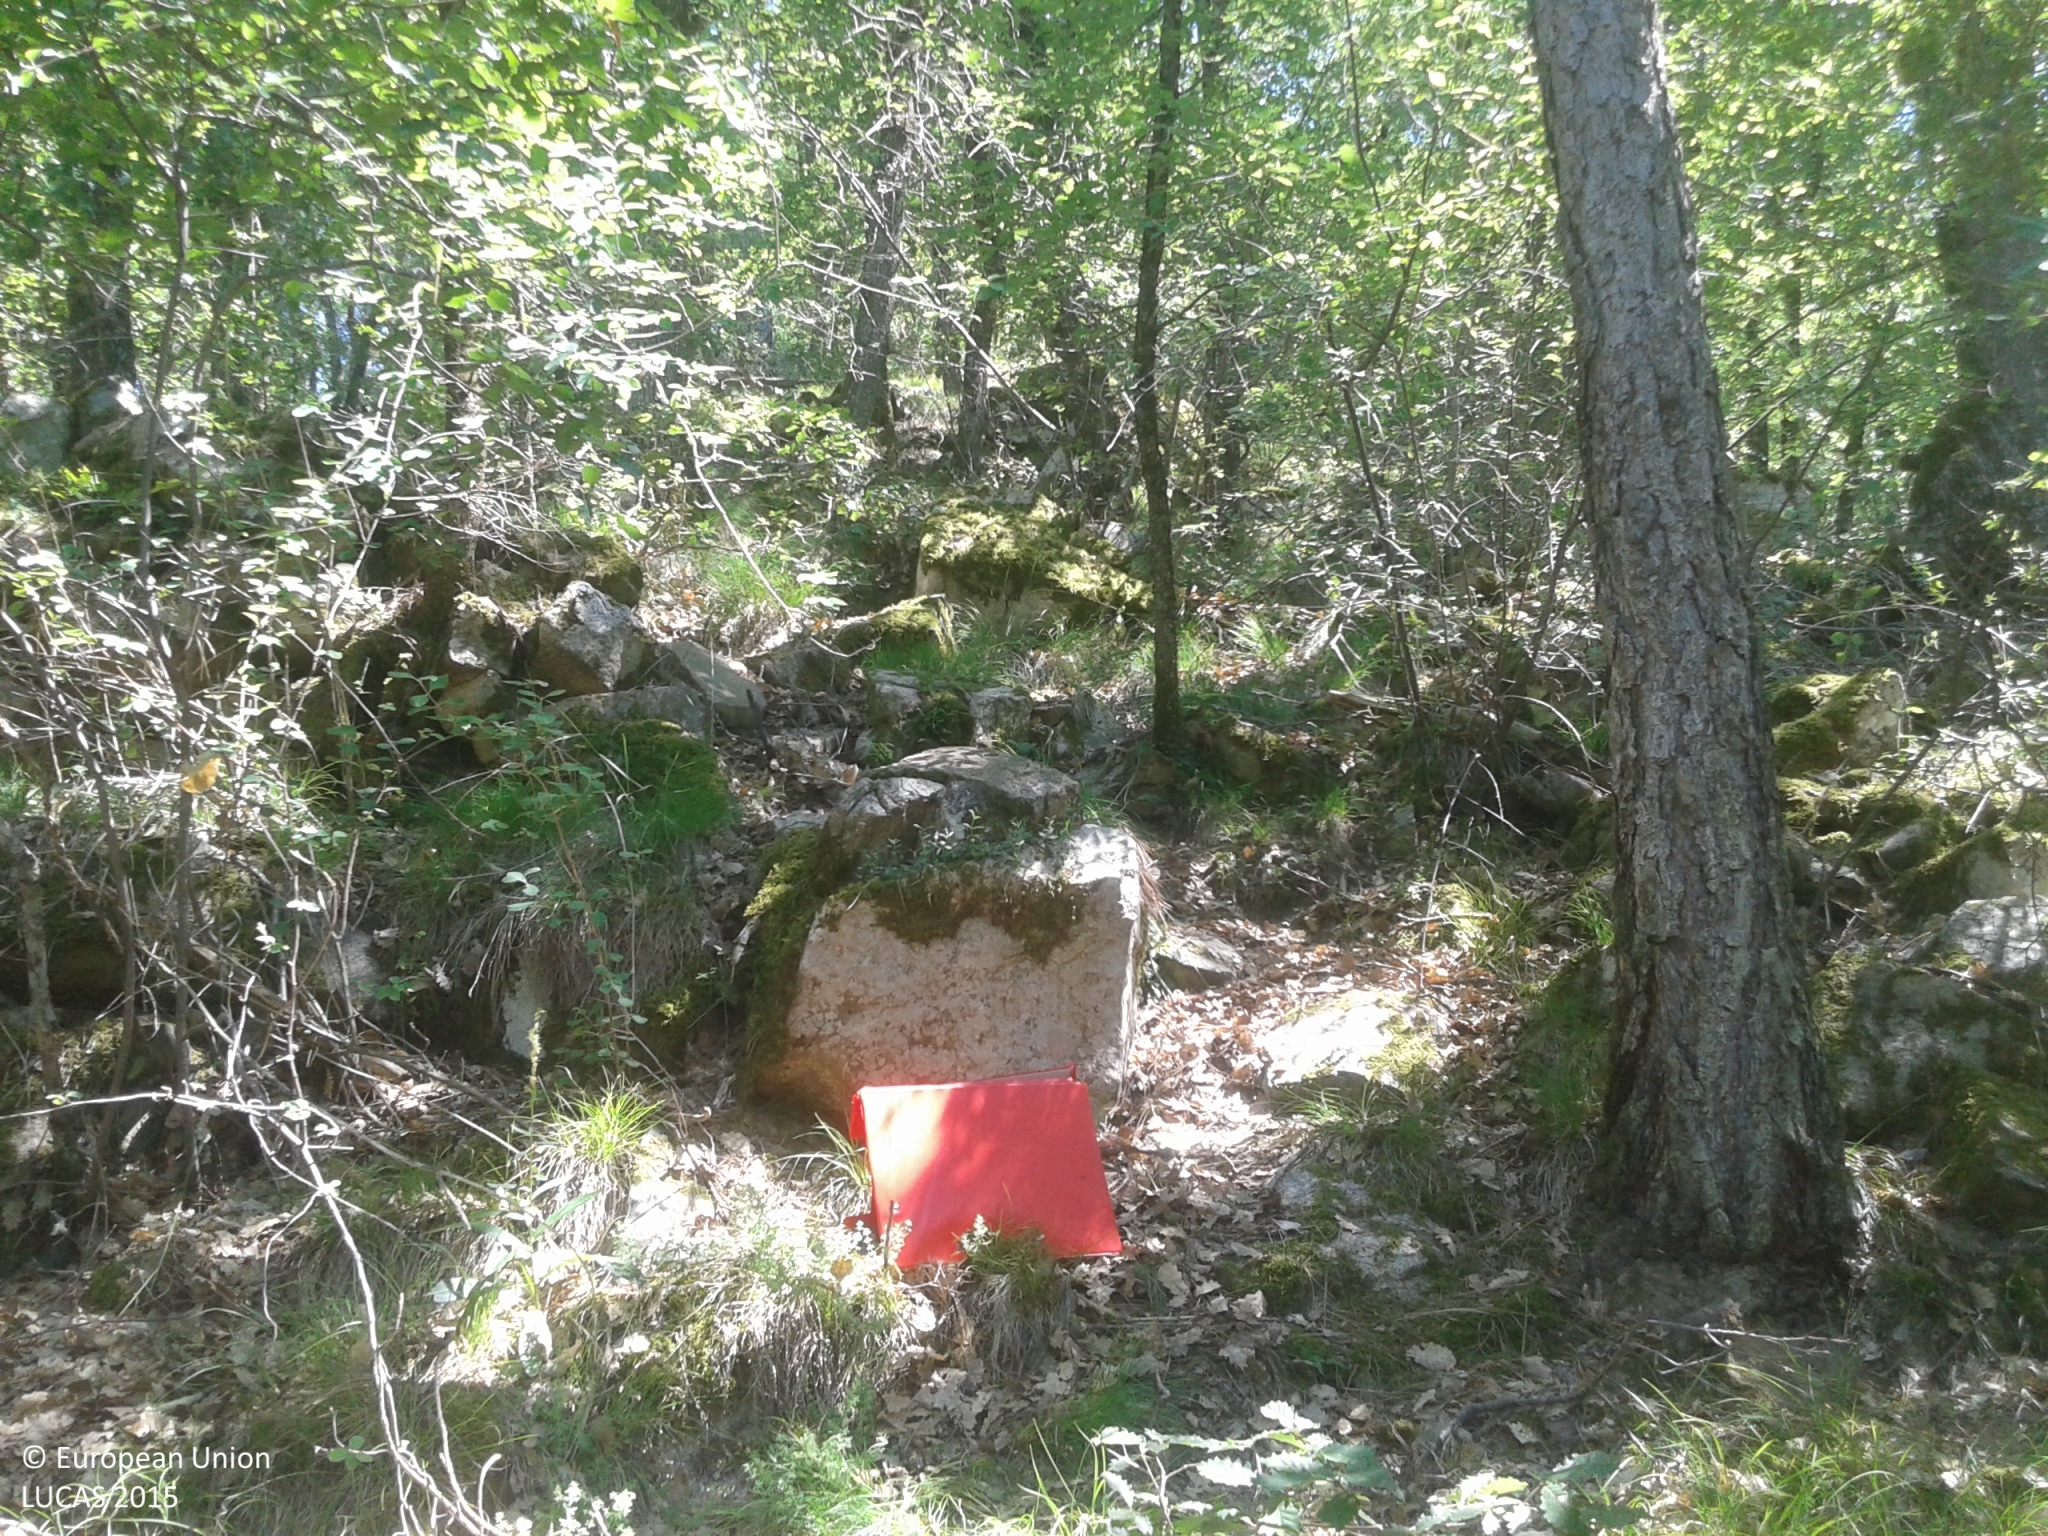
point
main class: Woodland
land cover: Other mixed woodland
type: coniferous forest of the mediterranean region
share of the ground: > 75 %
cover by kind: broadleaved forest trees 55 %, coniferous forest trees 35 %, herbaceous plants 5 %, lichens and mosses 5 %
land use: Semi-natural and natural areas not in use
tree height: > 5 m
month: June
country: ES
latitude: 42.3567
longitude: 1.5725
